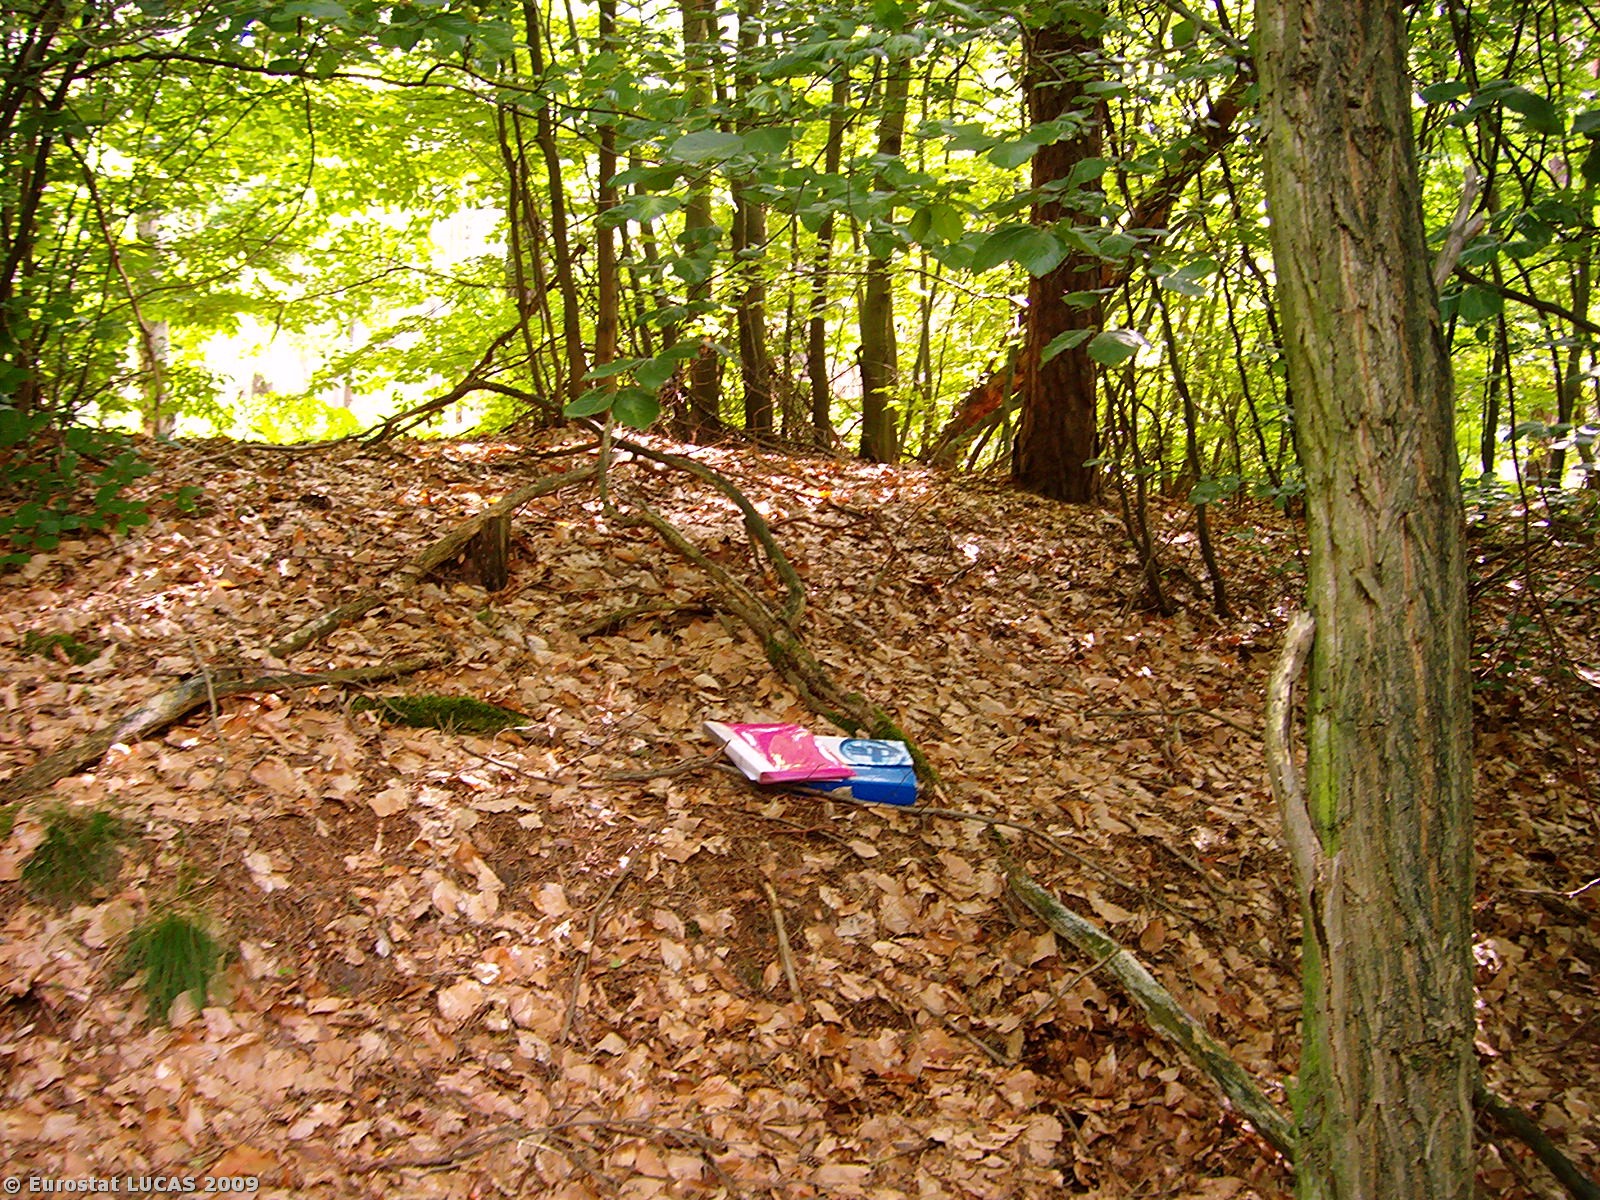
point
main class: Woodland
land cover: Mixed woodland
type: hemiboreal forest and nemoral coniferous forest and mixed broadleaved-coniferous forest
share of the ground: > 75 %
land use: Forestry
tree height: > 5 m
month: July
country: PL
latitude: 52.5155
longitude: 15.2049
